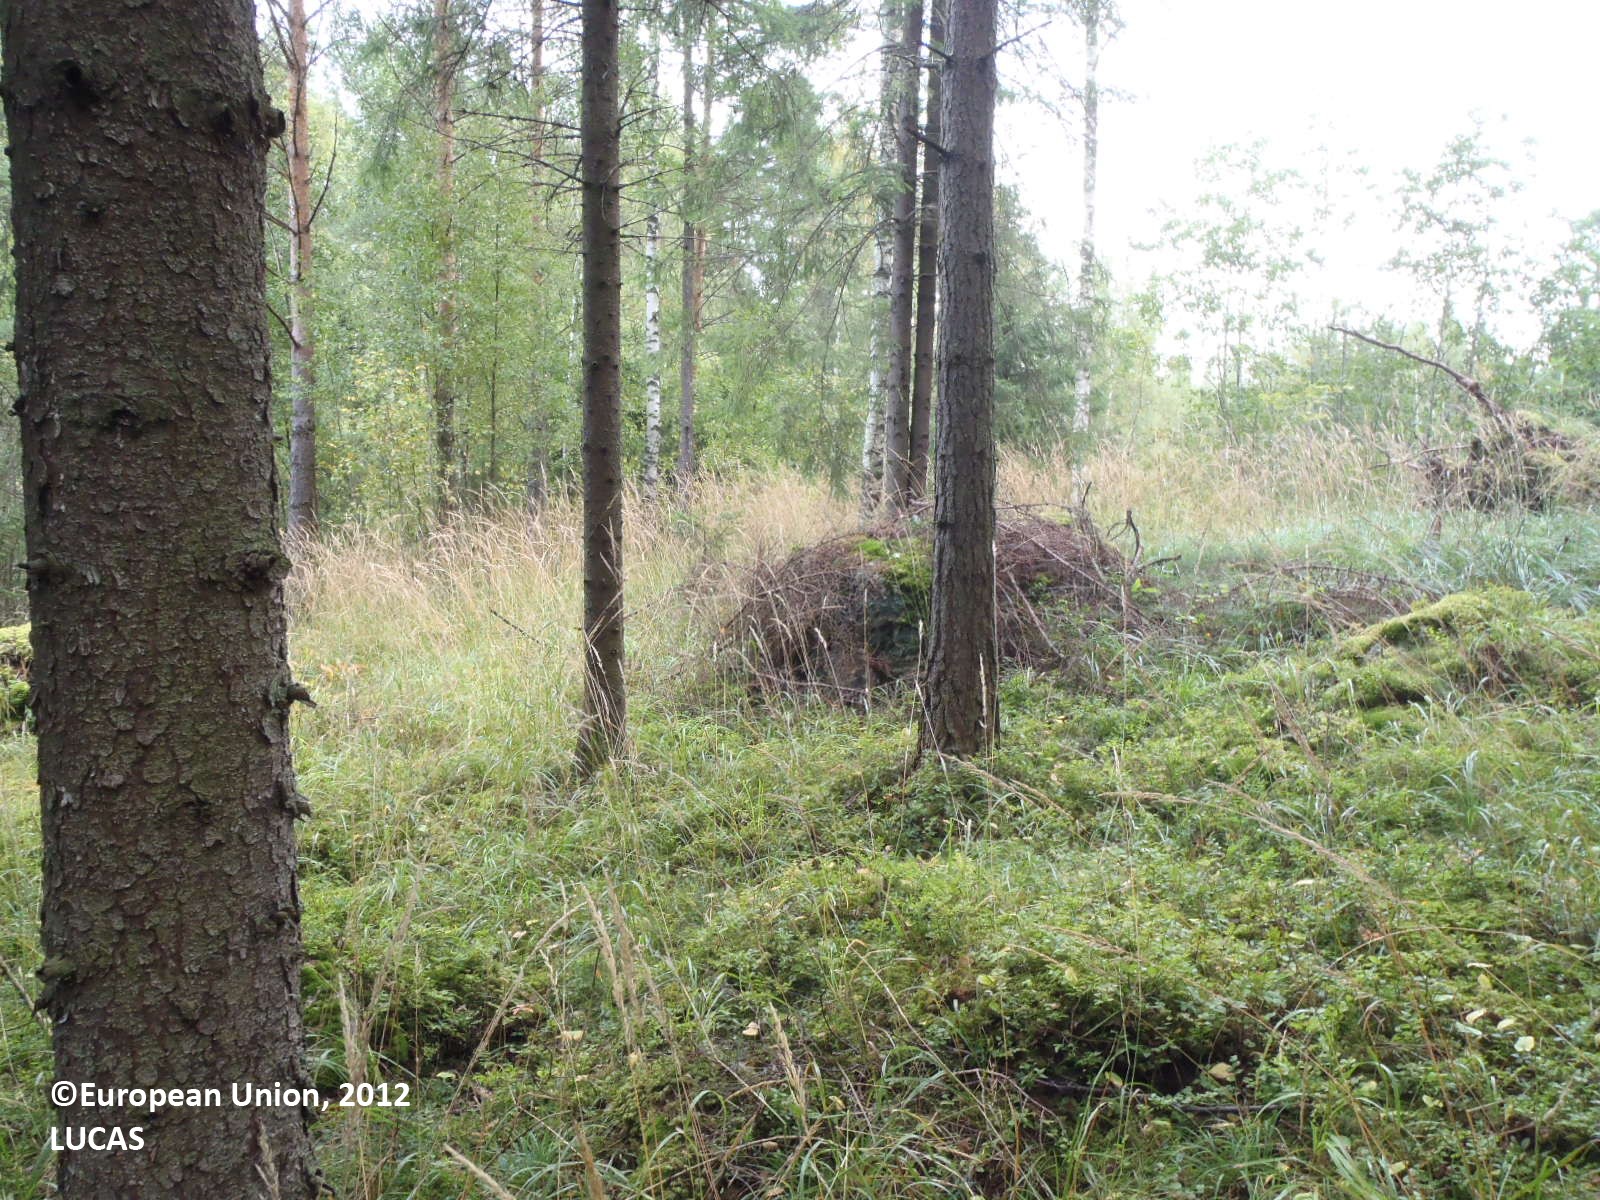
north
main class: Woodland
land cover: Spruce dominated coniferous woodland
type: boreal forest
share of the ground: > 75 %
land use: Forestry
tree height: > 5 m
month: August
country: FI
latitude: 60.8498
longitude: 22.4532
